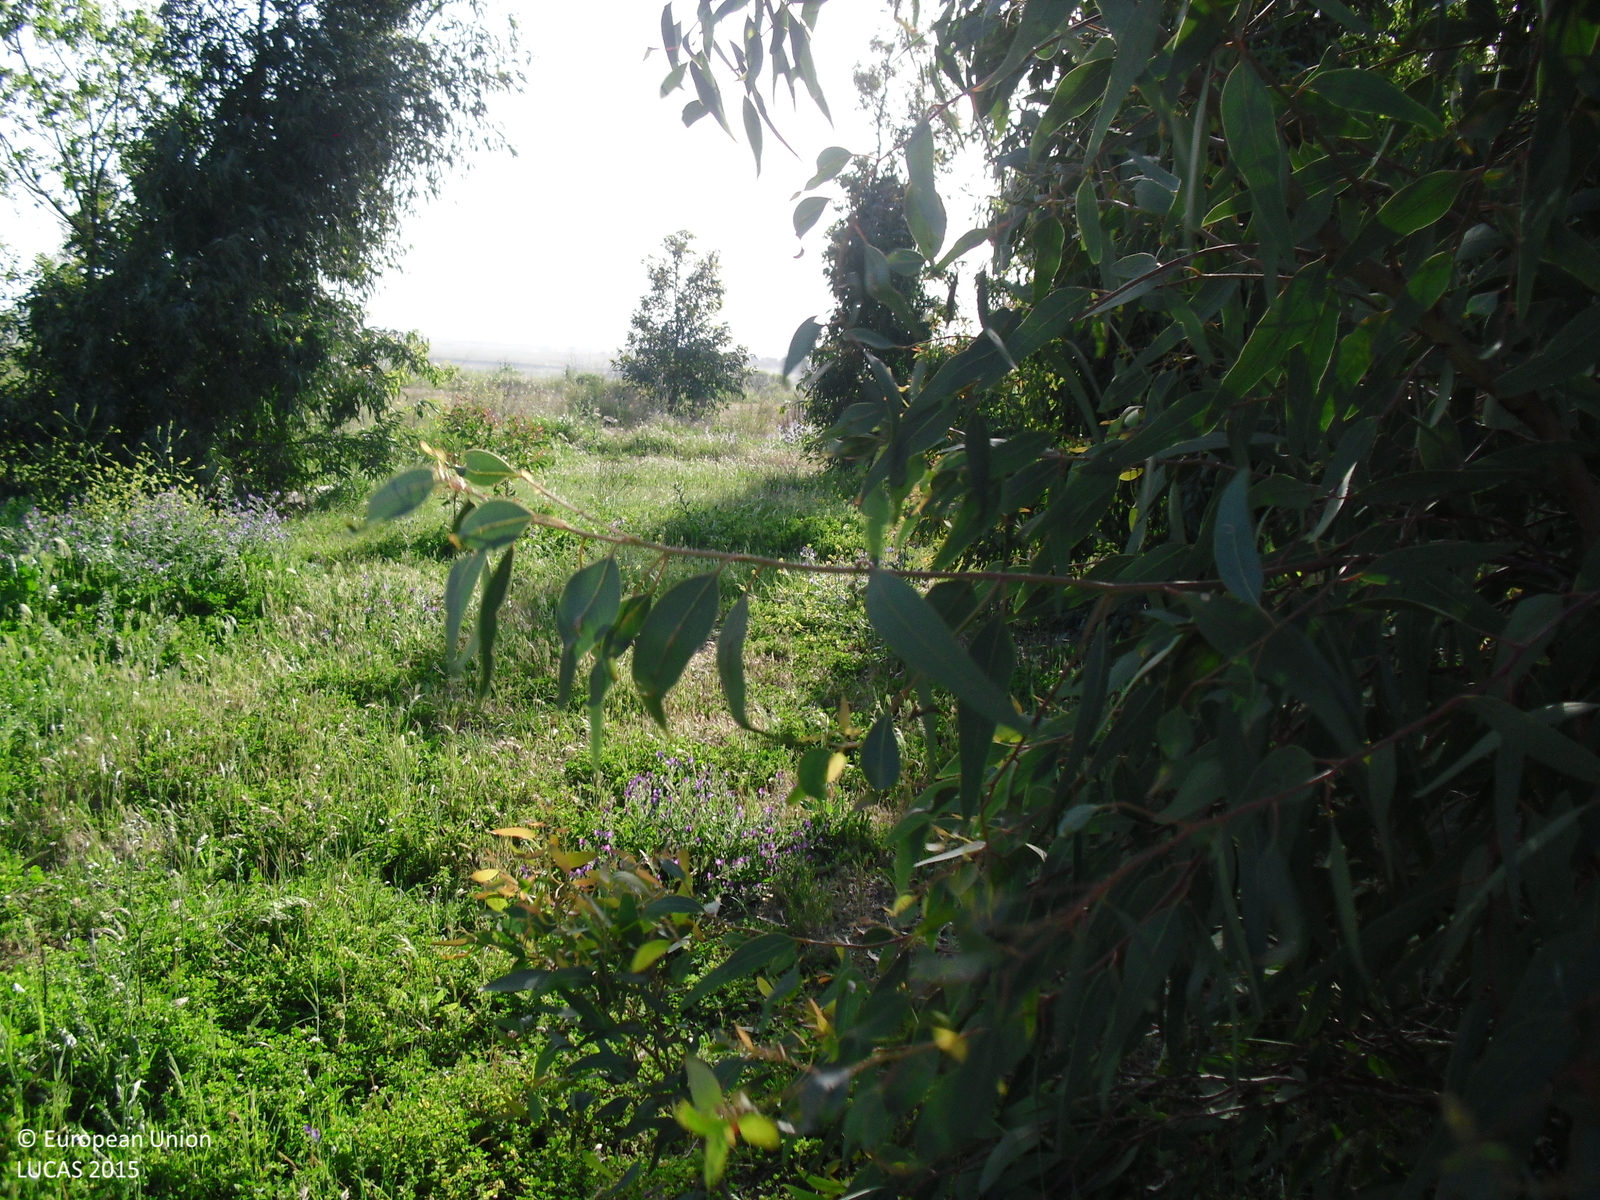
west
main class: Grassland
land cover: Grassland with sparse tree/shrub cover
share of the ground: > 75 %
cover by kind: herbaceous plants 95 %, broadleaved forest trees 5 %
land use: Abandoned areas
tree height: < 5 m
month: April
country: ES
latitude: 39.4486
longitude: -6.3946
